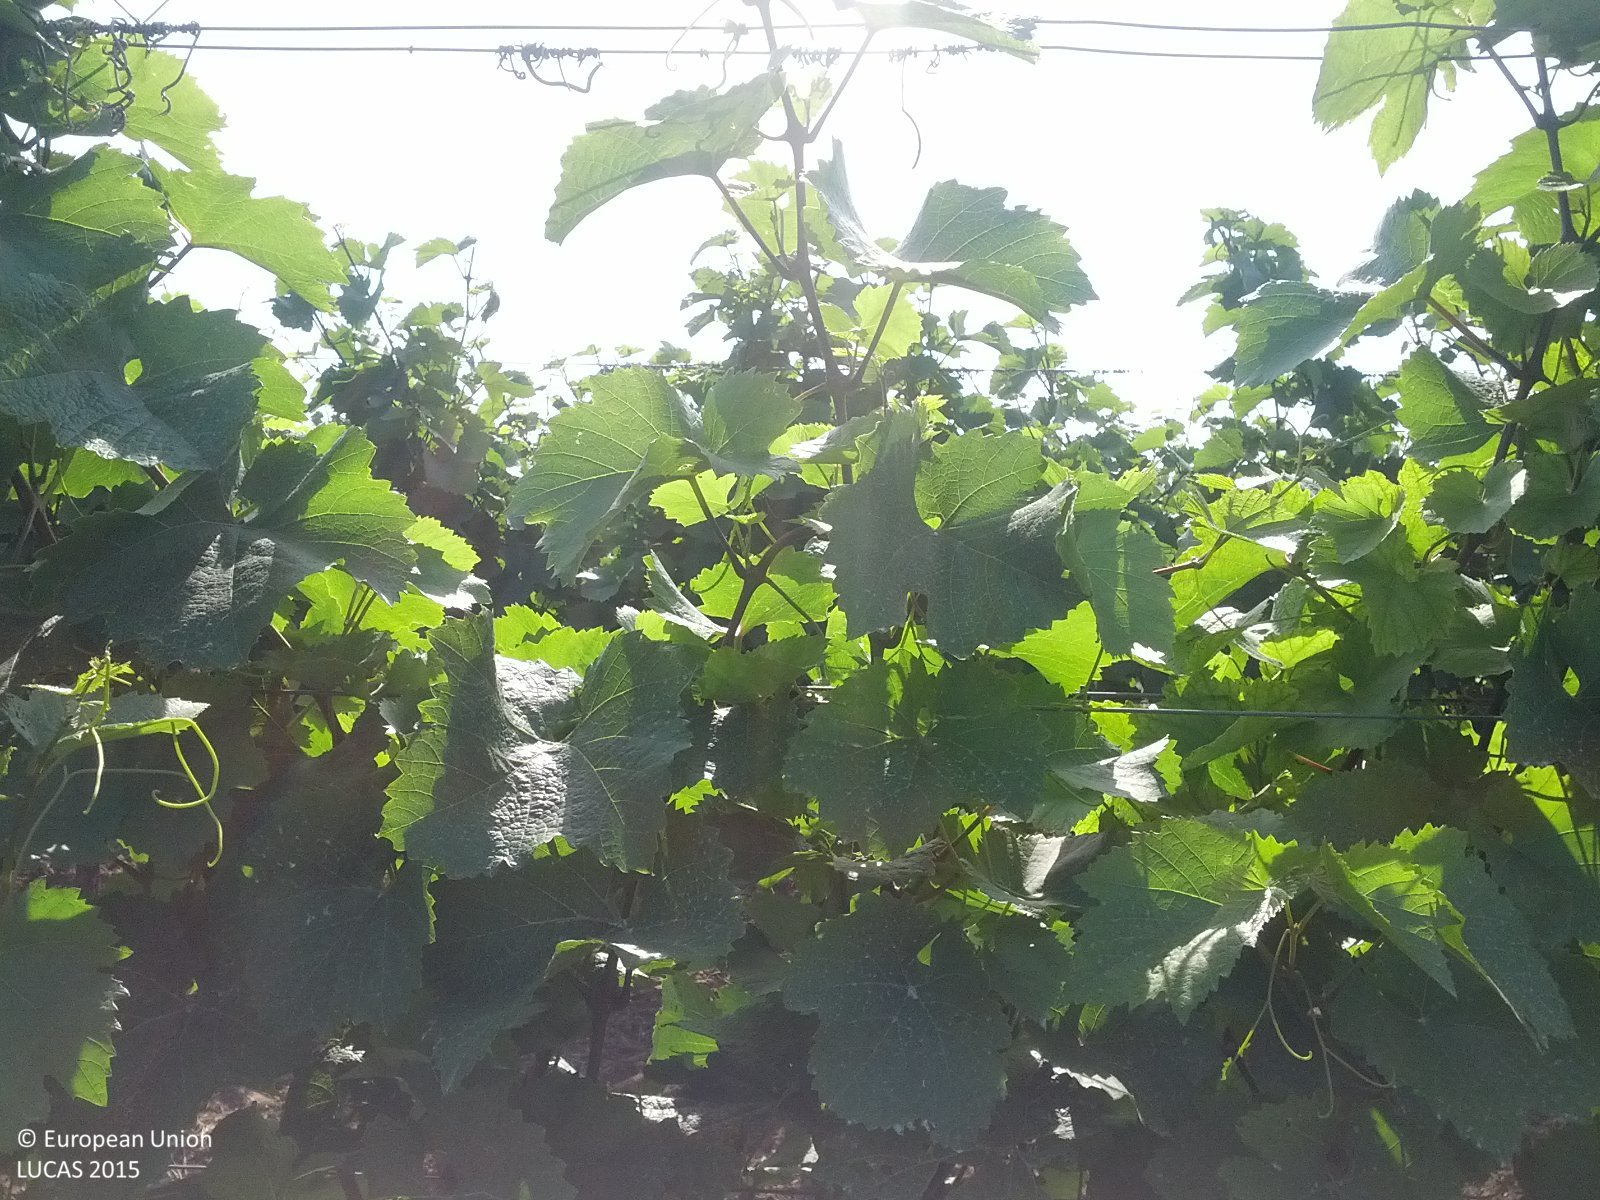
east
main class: Cropland
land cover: Vineyards
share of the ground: 10 - 25 %
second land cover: Other bare soil
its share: > 75 %
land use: Agriculture (excluding fallow land and kitchen gardens)
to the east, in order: Vineyards; Other bare soil; Grass margins; Common wheat; Maize; Electric lines; Maize; Vineyards
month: June
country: AT
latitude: 48.6728
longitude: 16.6475
